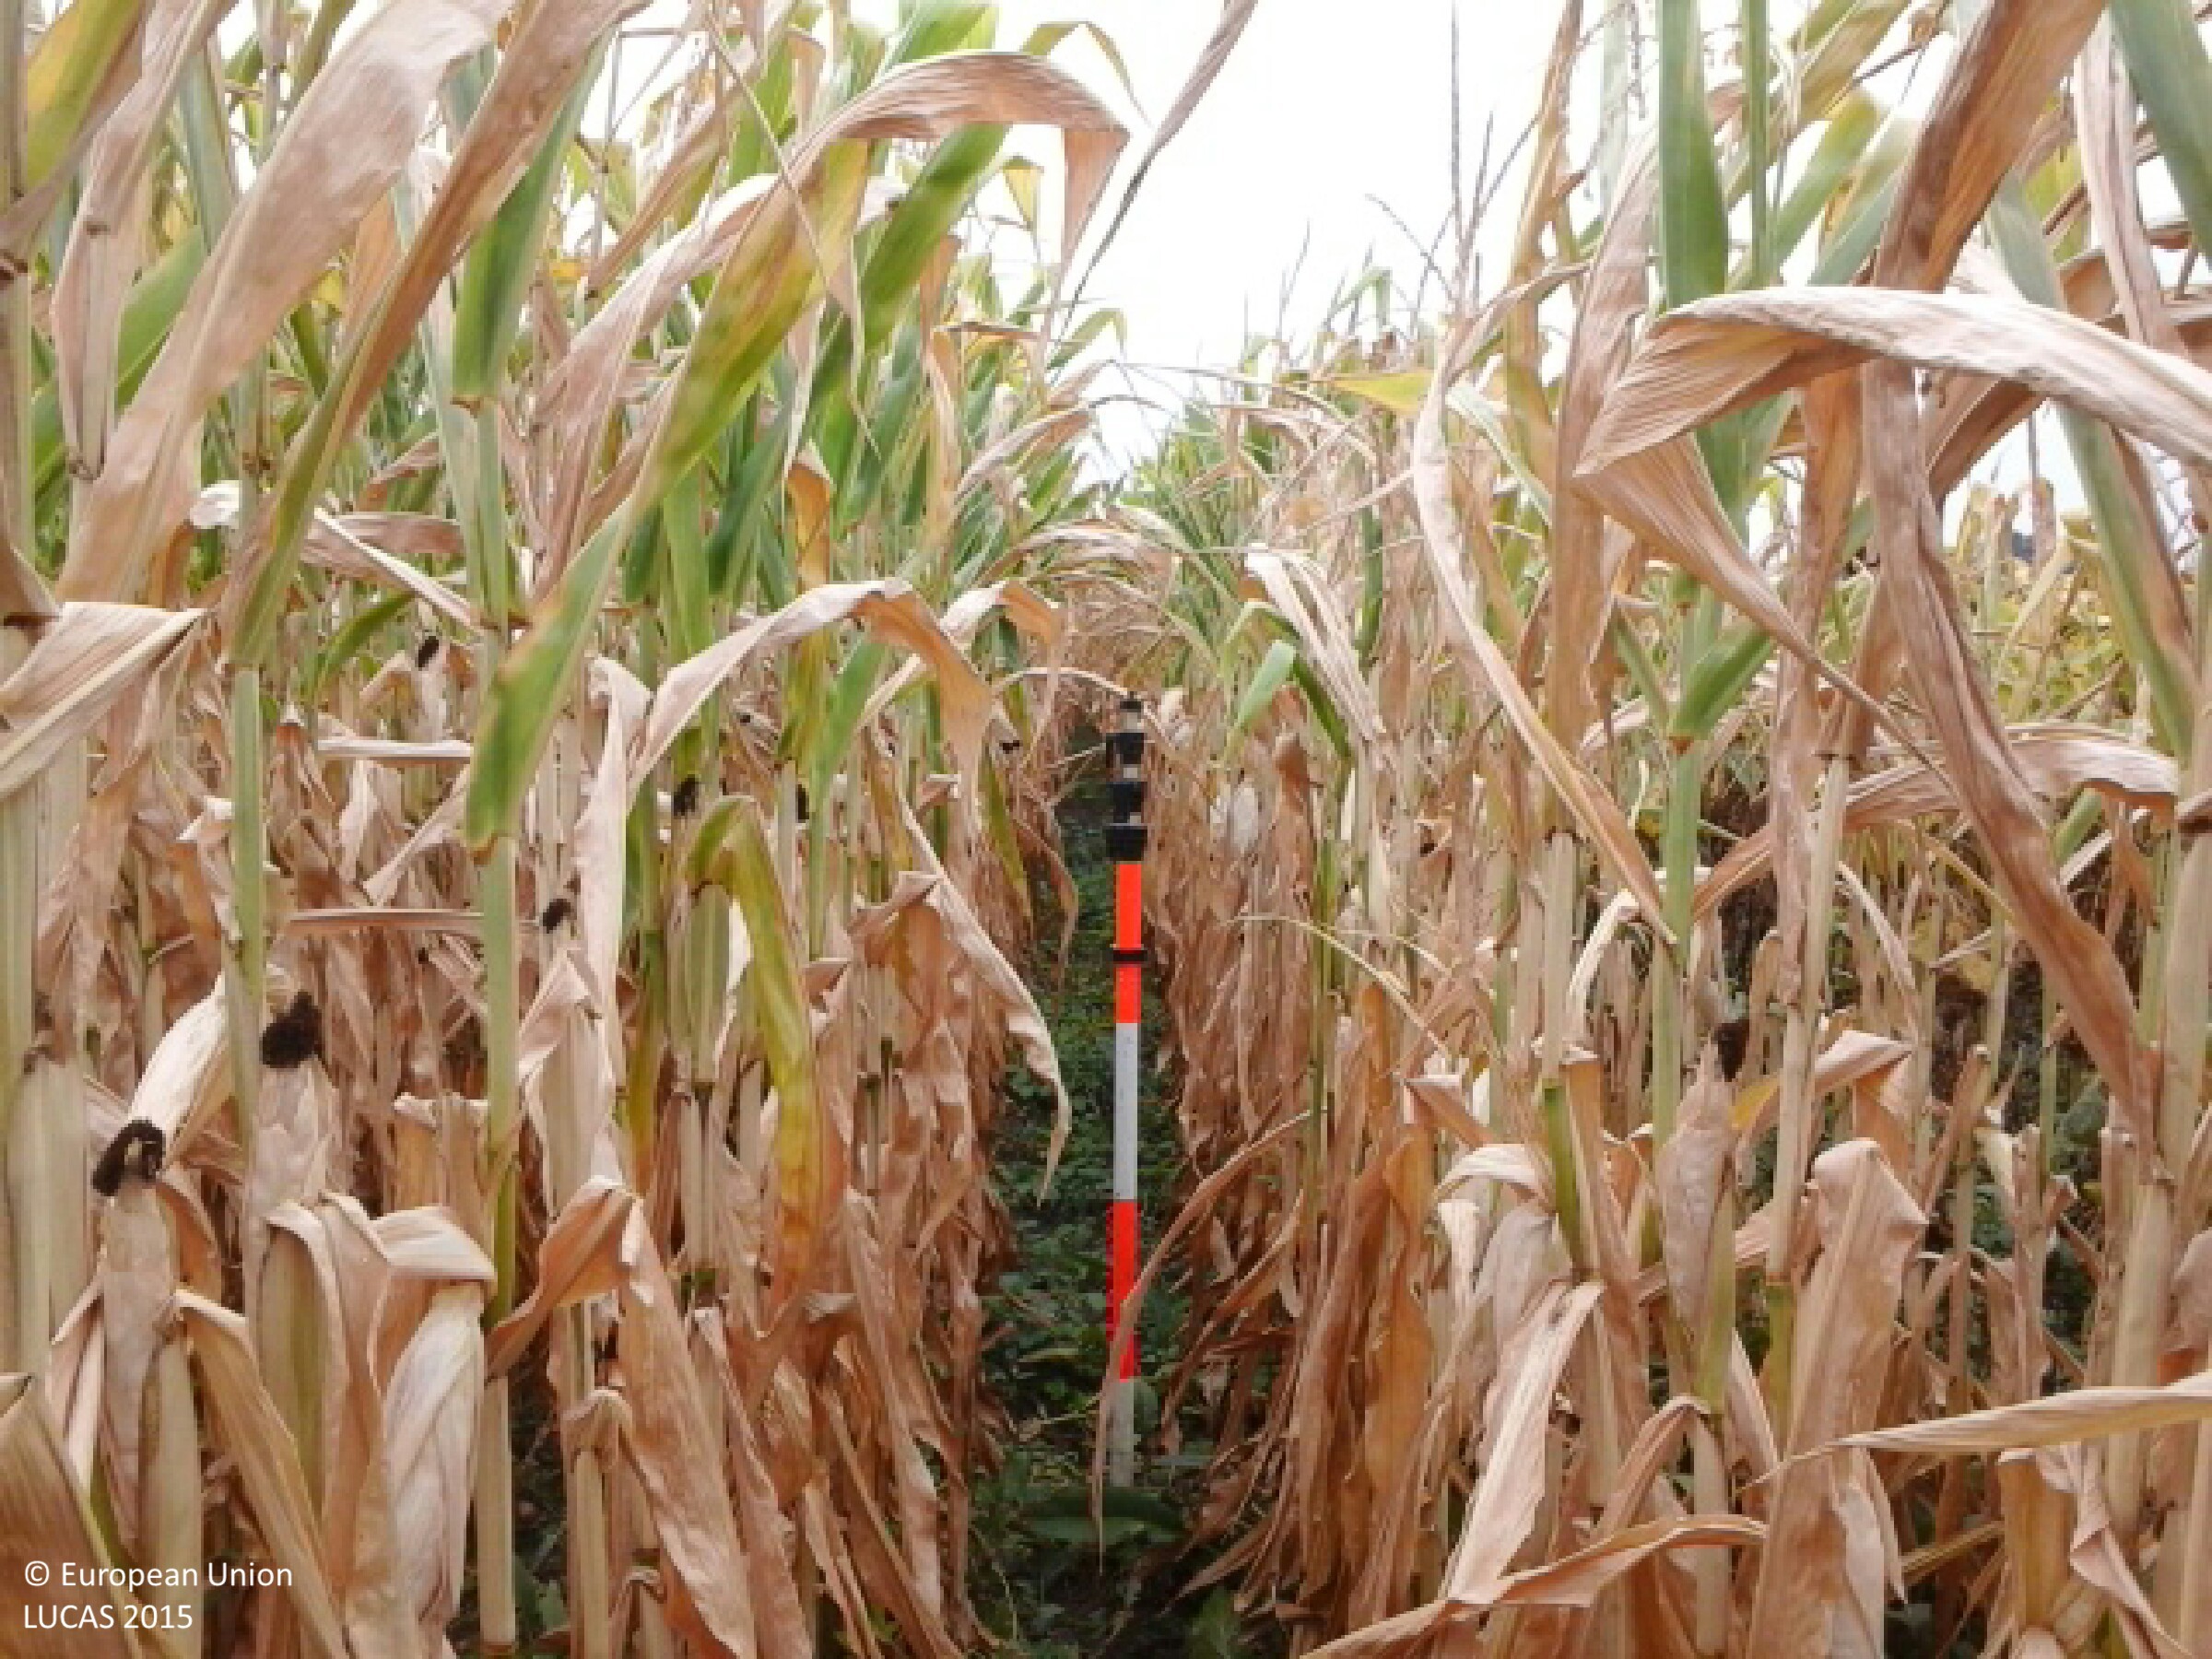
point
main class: Cropland
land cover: Maize
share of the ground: > 75 %
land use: Agriculture (excluding fallow land and kitchen gardens)
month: August
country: HU
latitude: 47.1747
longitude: 21.7477
